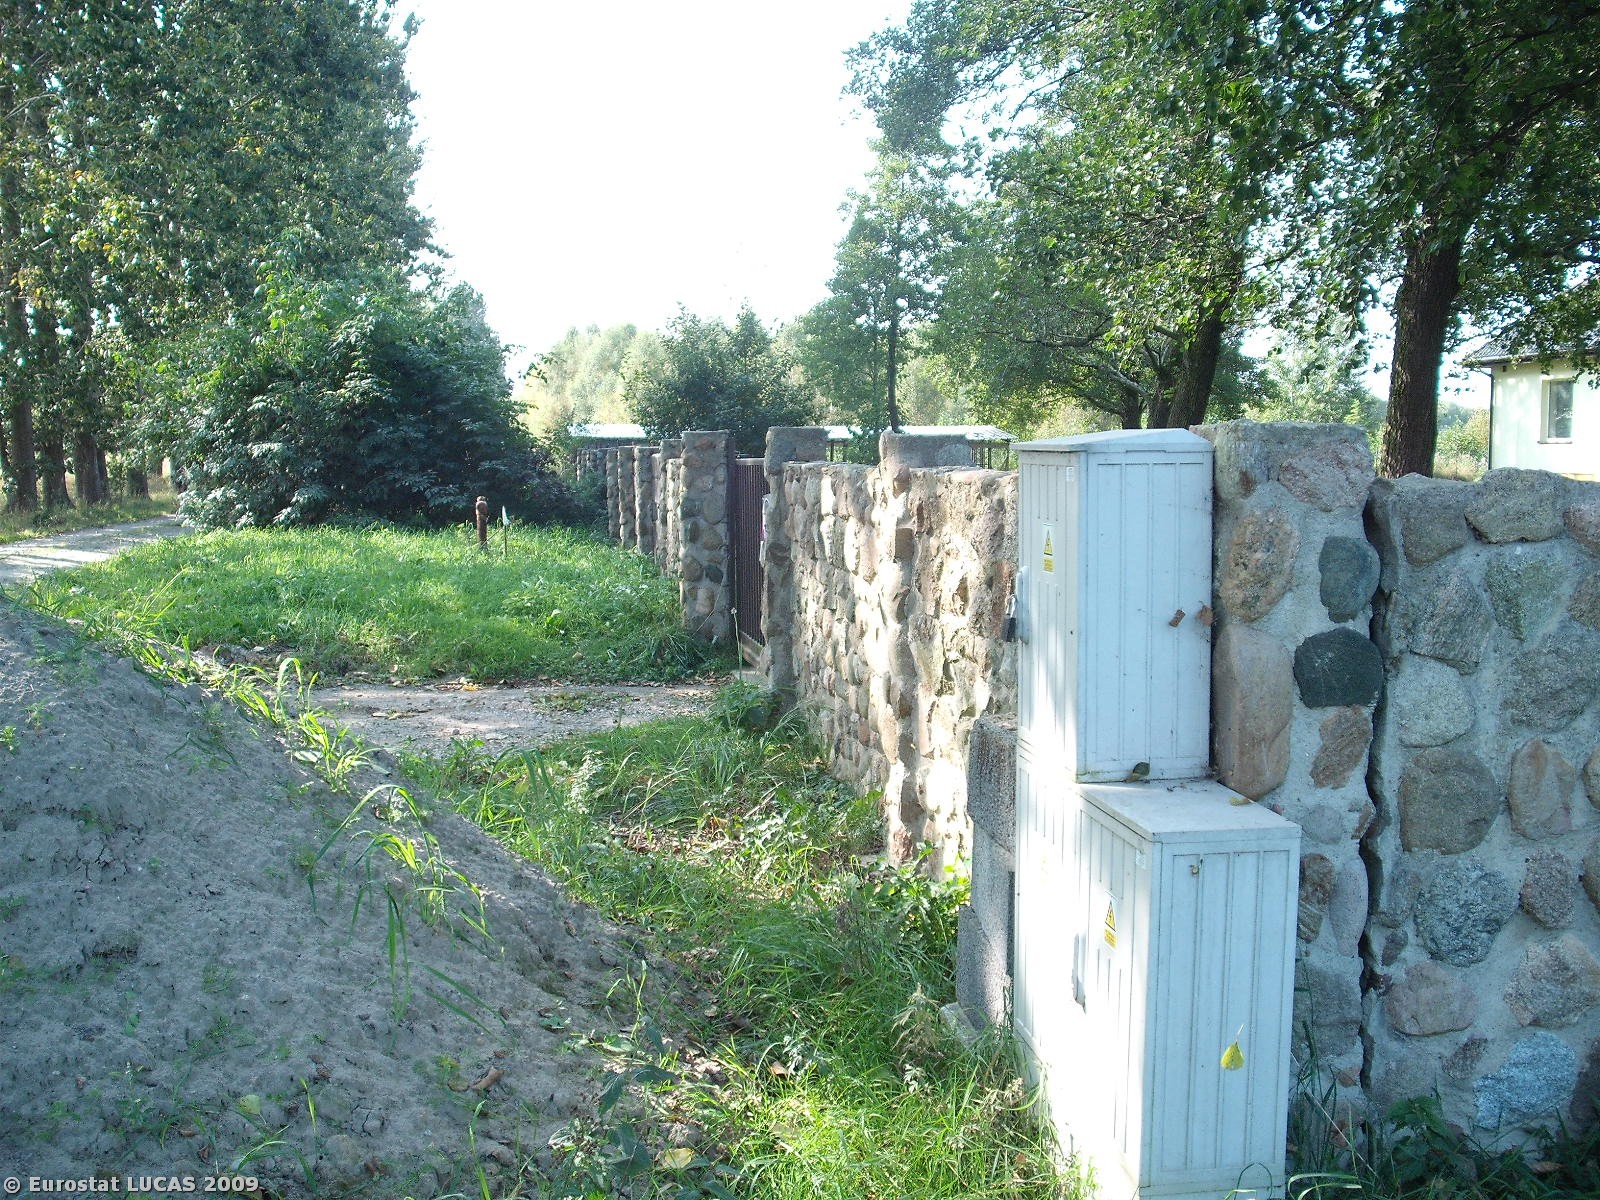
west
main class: Grassland
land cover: Spontaneously vegetated surfaces
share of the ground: > 75 %
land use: Unused
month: September
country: PL
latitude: 52.0351
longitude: 20.7261
